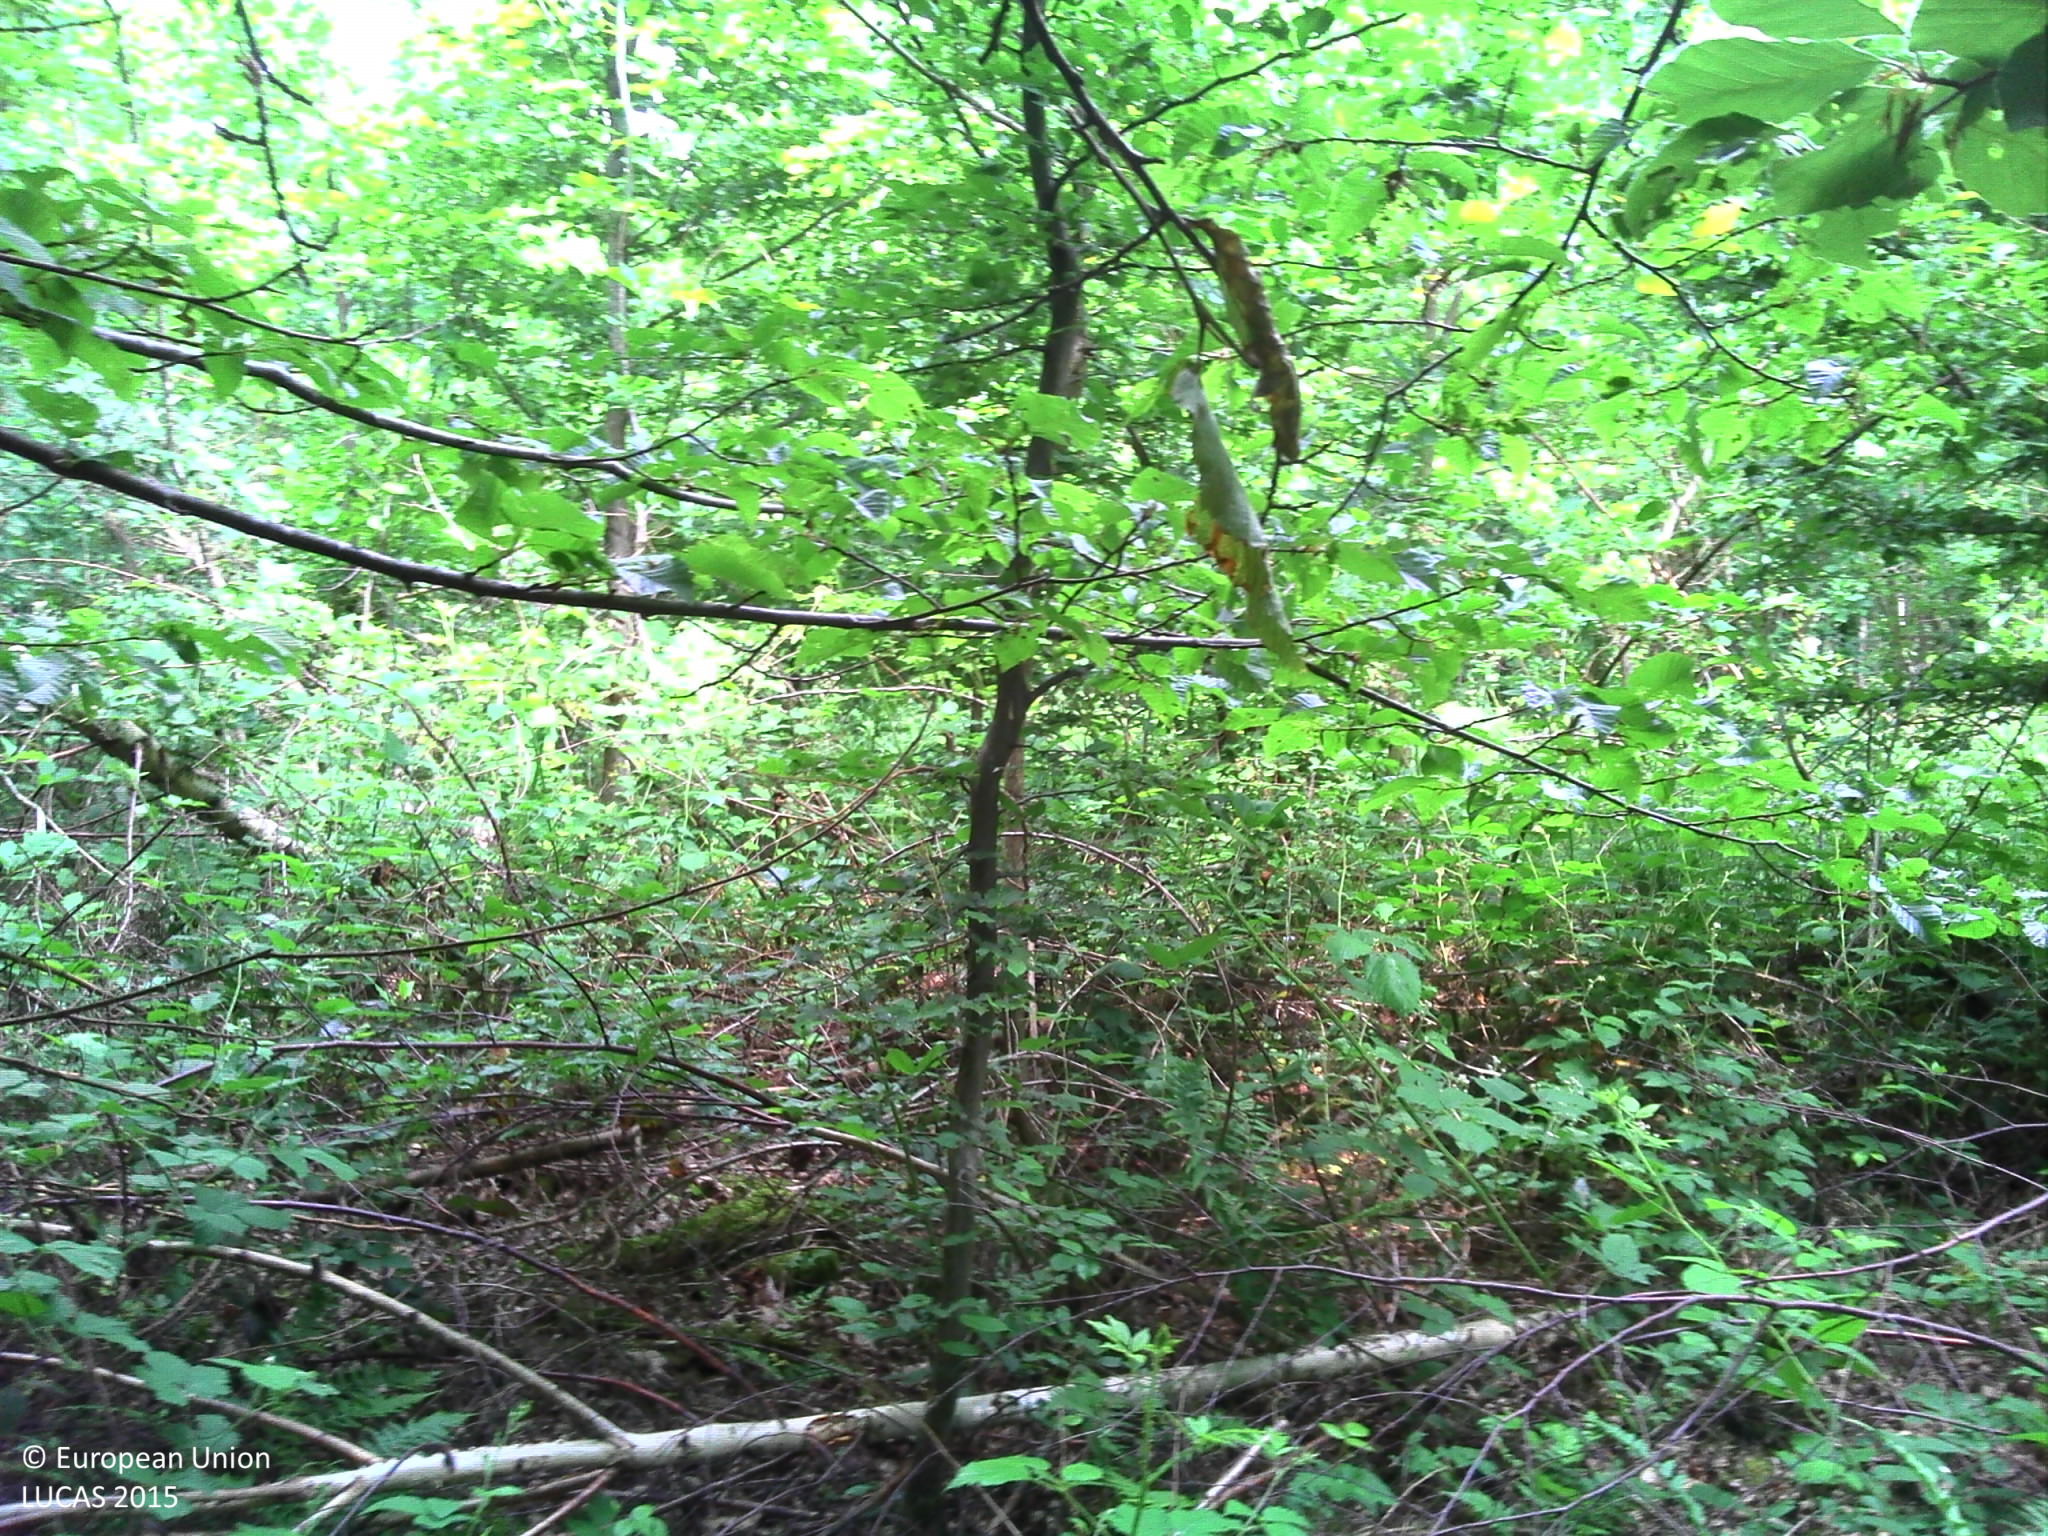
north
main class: Woodland
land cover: Broadleaved woodland
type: mesophytic deciduous forest
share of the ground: > 75 %
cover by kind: broadleaved forest trees 95 %, lichens and mosses 5 %
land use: Forestry
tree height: > 5 m
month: June
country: FR
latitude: 48.5371
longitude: 6.2215
